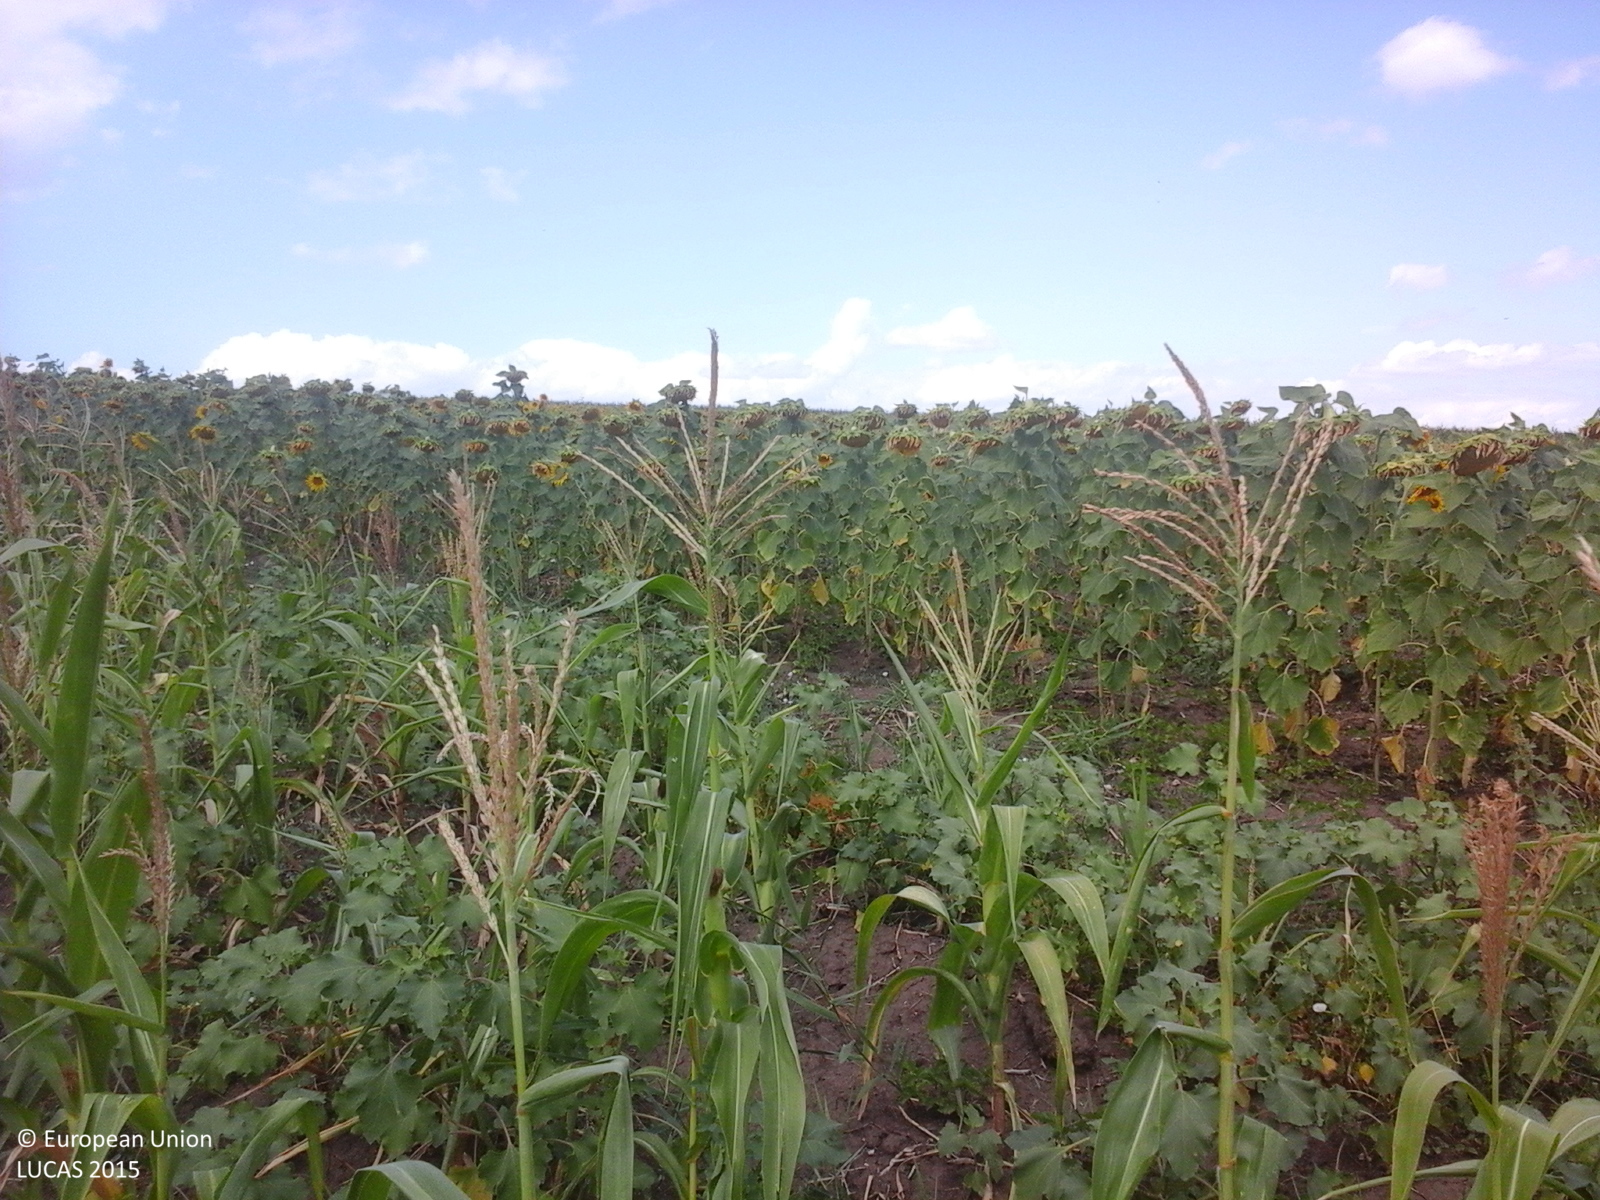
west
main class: Cropland
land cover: Maize
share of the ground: > 75 %
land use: Agriculture (excluding fallow land and kitchen gardens)
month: July
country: RO
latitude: 46.3660
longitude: 27.9443
